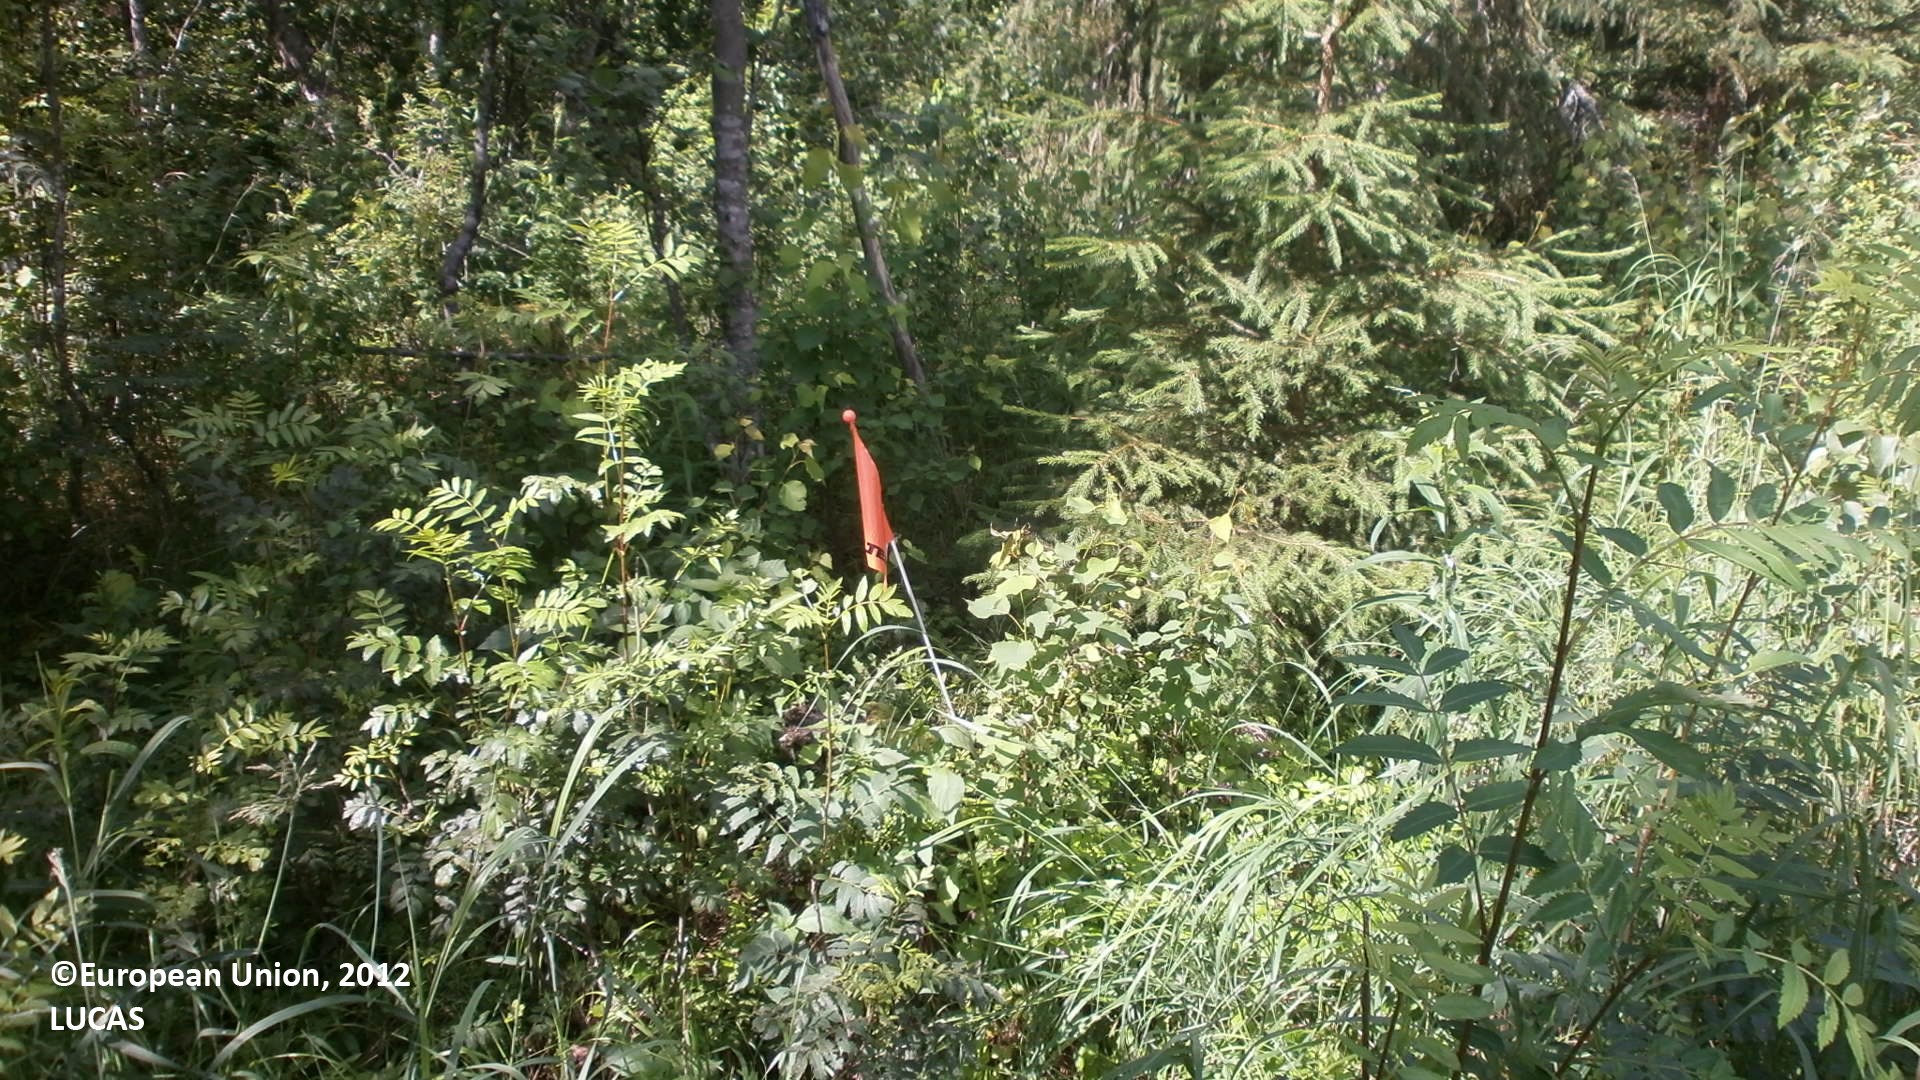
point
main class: Woodland
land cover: Spruce dominated mixed woodland
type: boreal forest
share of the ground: 50 - 75 %
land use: Forestry
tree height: > 5 m
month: July
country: FI
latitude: 64.4277
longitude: 24.5007
